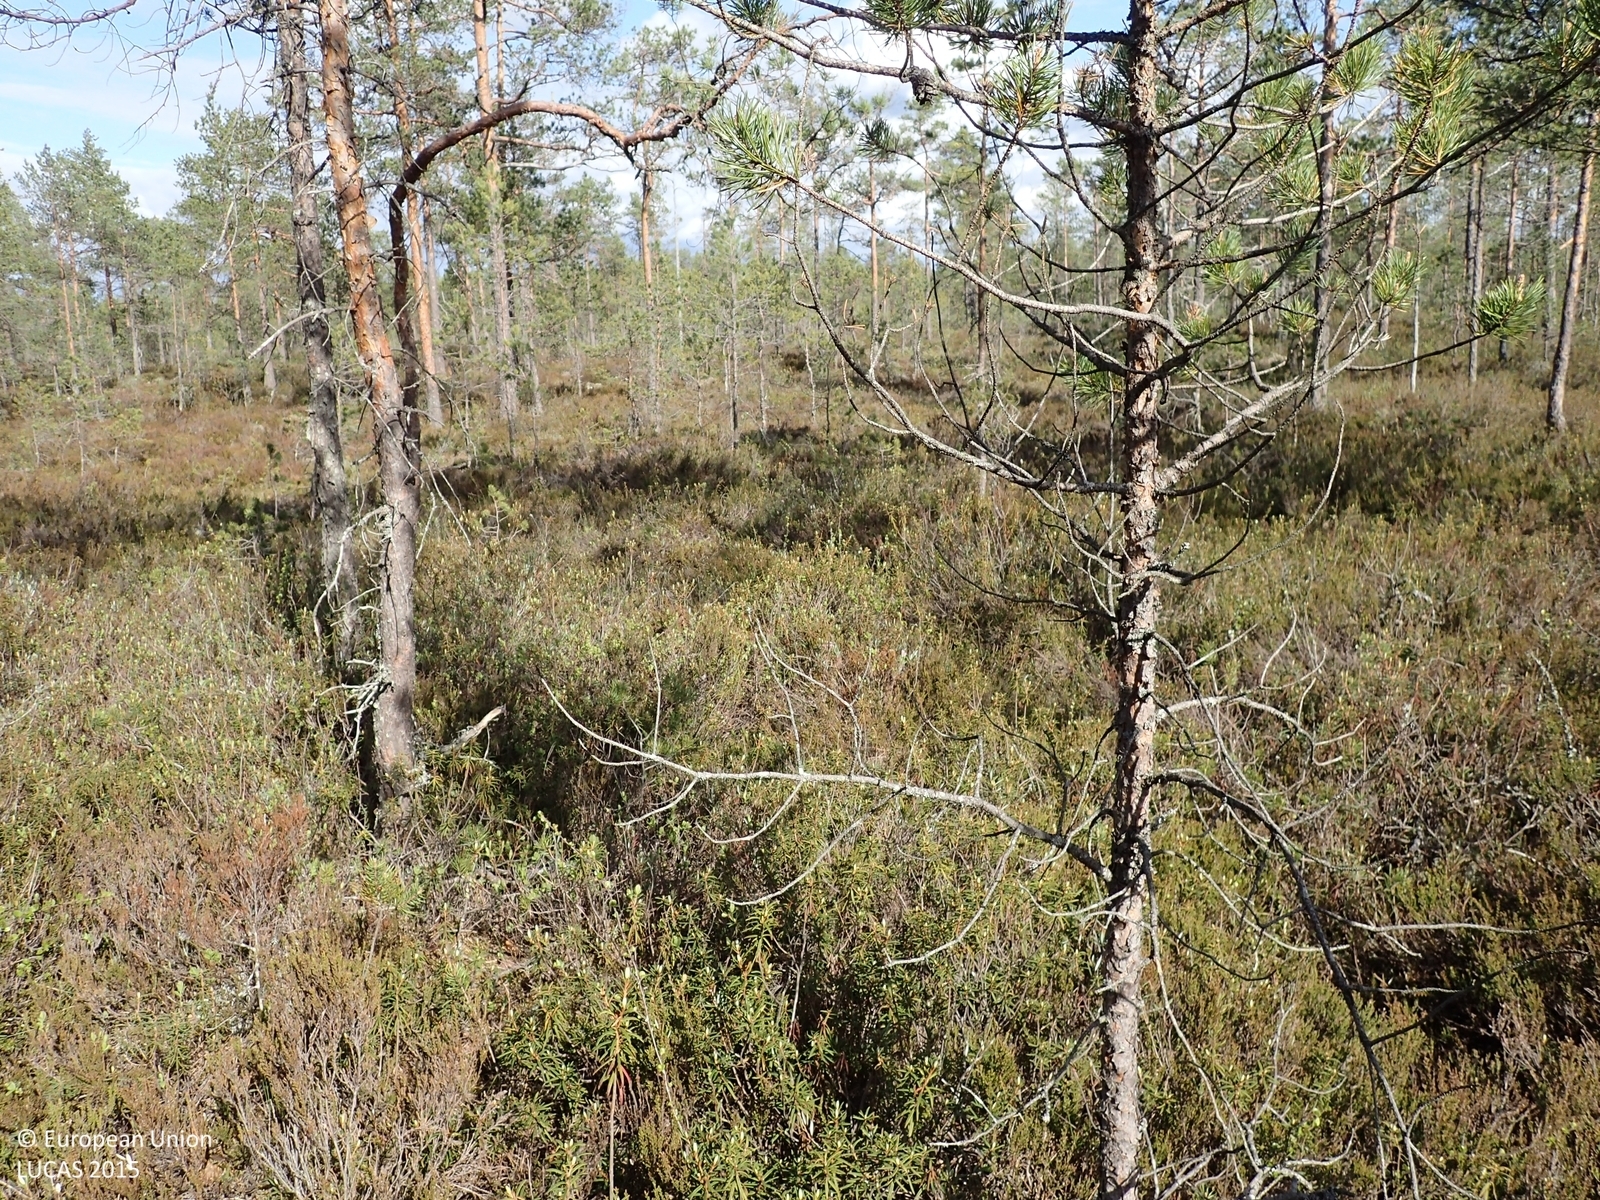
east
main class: Woodland
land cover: Pine dominated coniferous woodland
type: mire and swamp forests
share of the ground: 50 - 75 %
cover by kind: coniferous forest trees 50 %, shrubs 50 %
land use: Semi-natural and natural areas not in use
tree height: > 5 m
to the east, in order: Pine dominated coniferous woodland; Ditches and canals; Pine dominated coniferous woodland
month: June
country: FI
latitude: 62.2729
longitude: 21.8204
